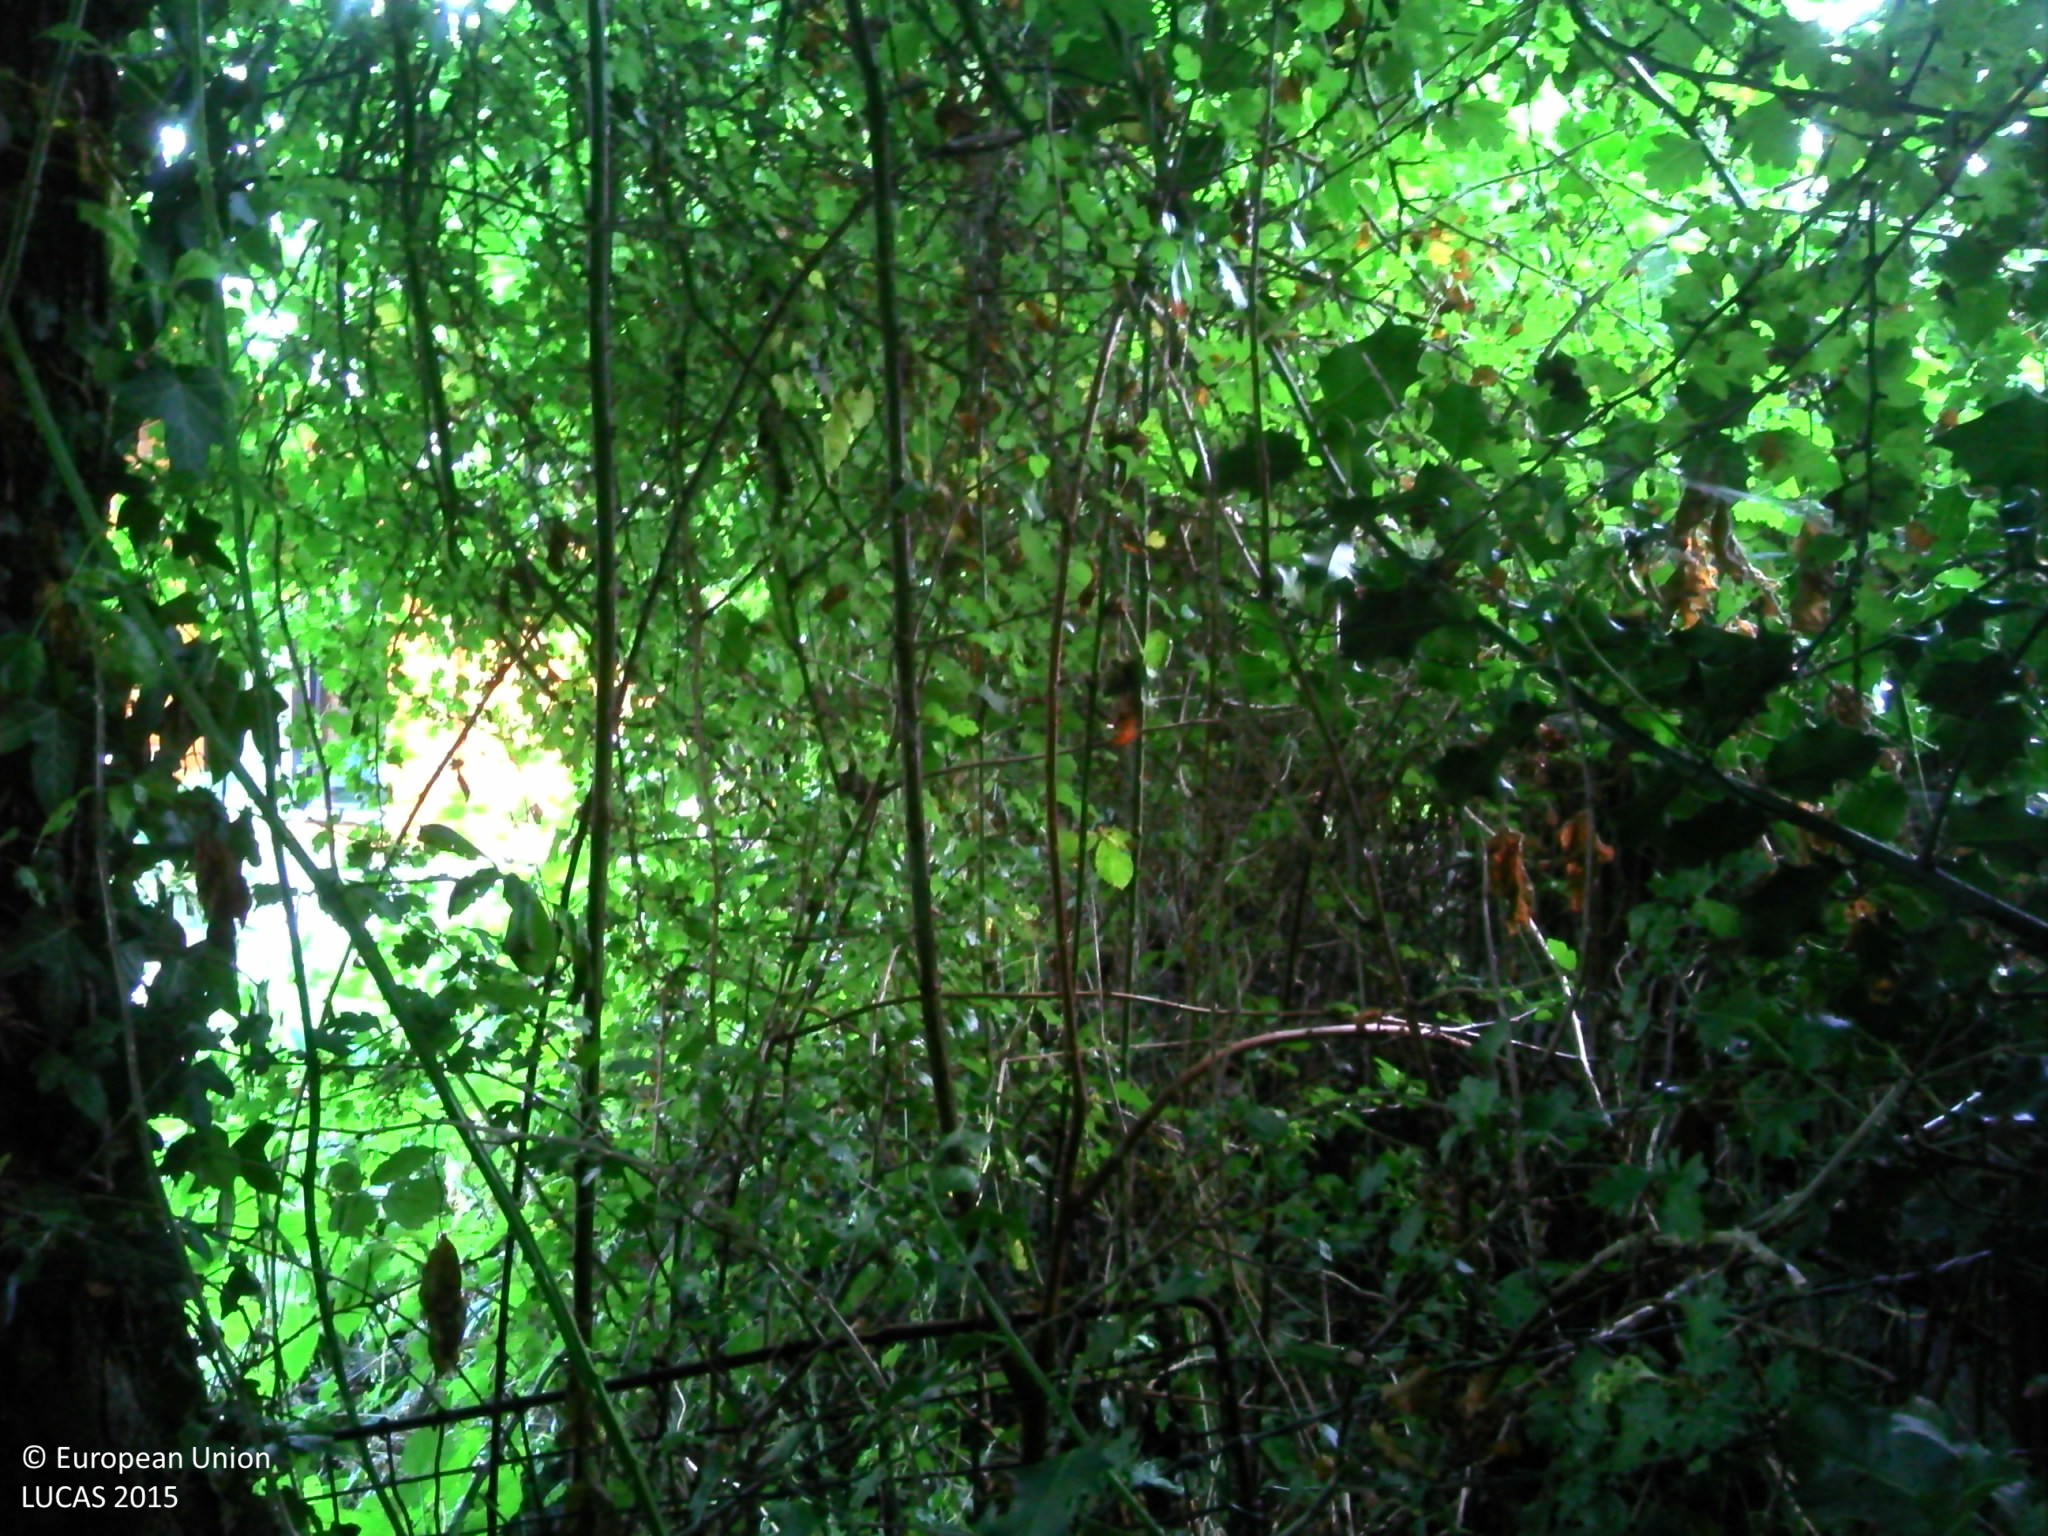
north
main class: Woodland
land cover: Broadleaved woodland
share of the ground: > 75 %
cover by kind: broadleaved forest trees 90 %, herbaceous plants 10 %
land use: Residential
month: July
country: FR
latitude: 47.5180
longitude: -1.9341
